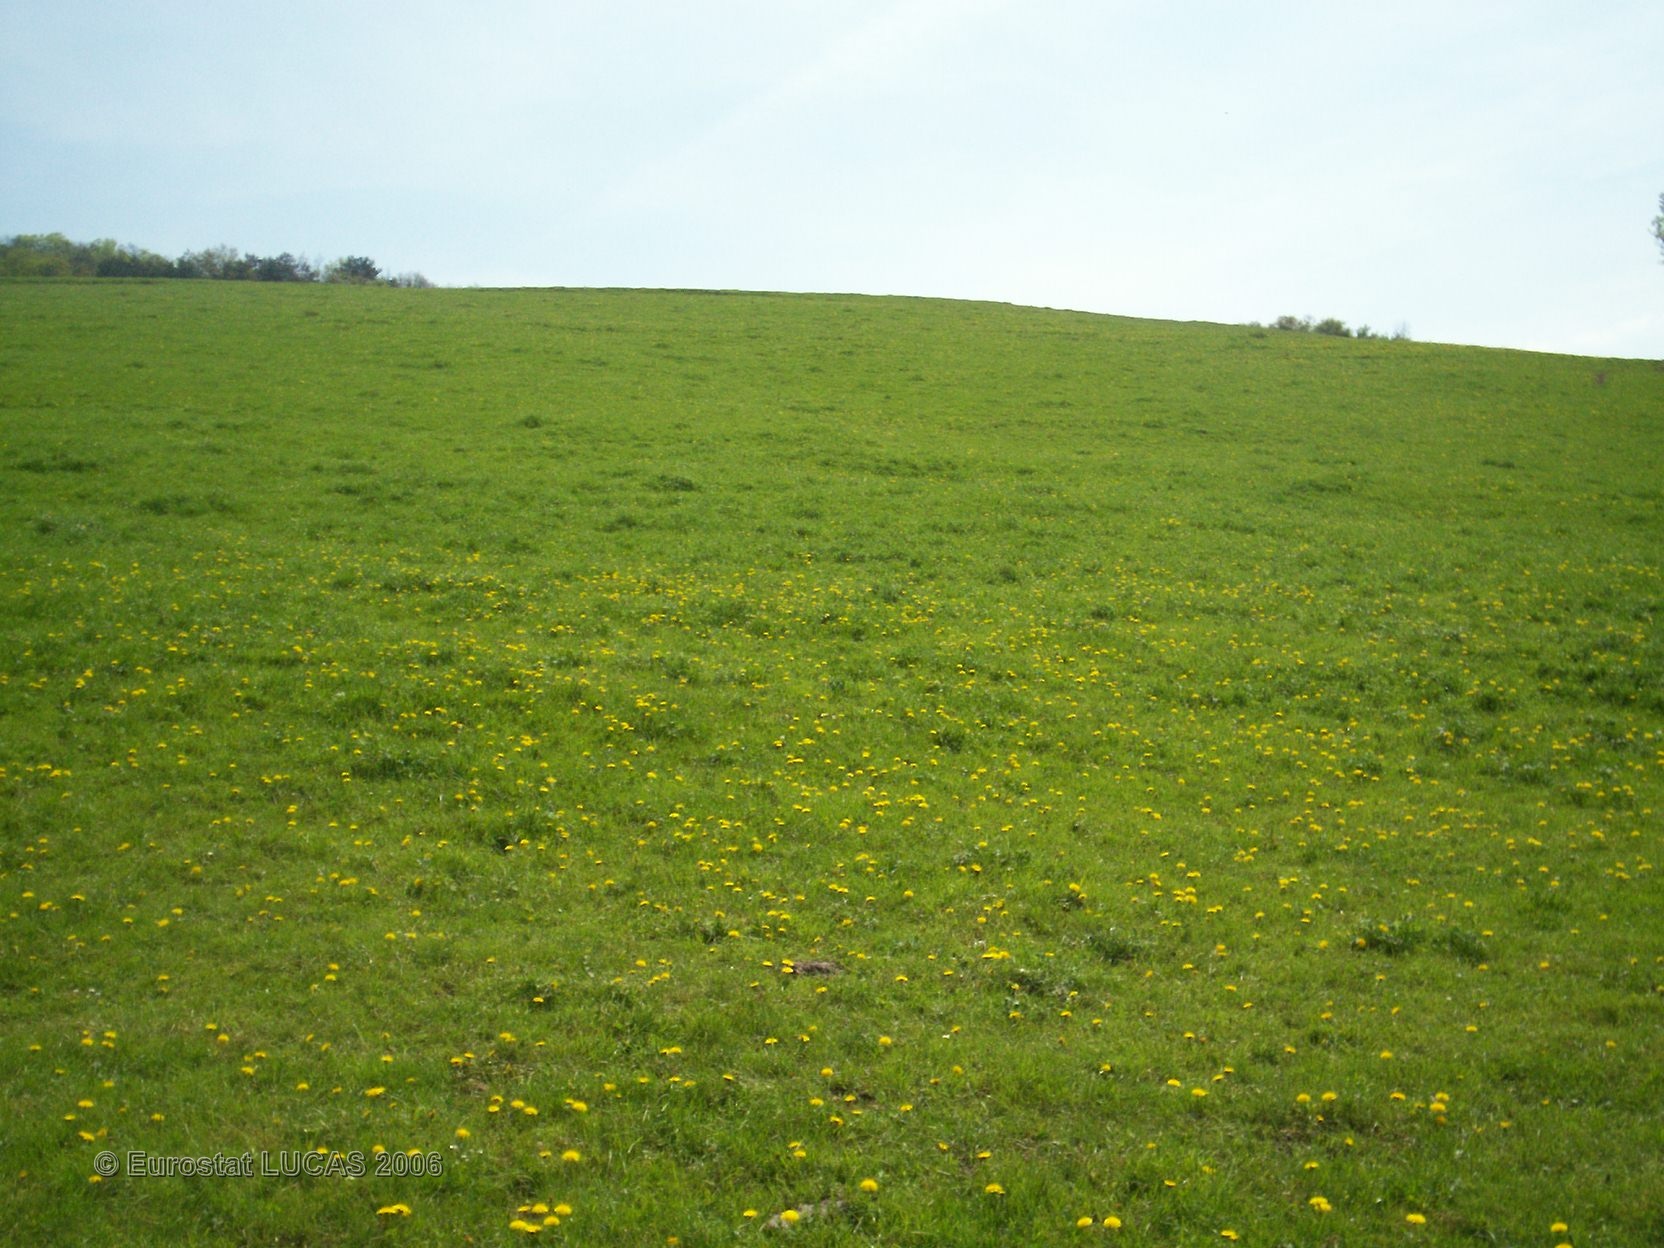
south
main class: Grassland
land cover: Grassland without tree/shrub cover
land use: Agriculture (excluding fallow land and kitchen gardens)
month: May
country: FR
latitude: 47.4779
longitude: 4.5986
